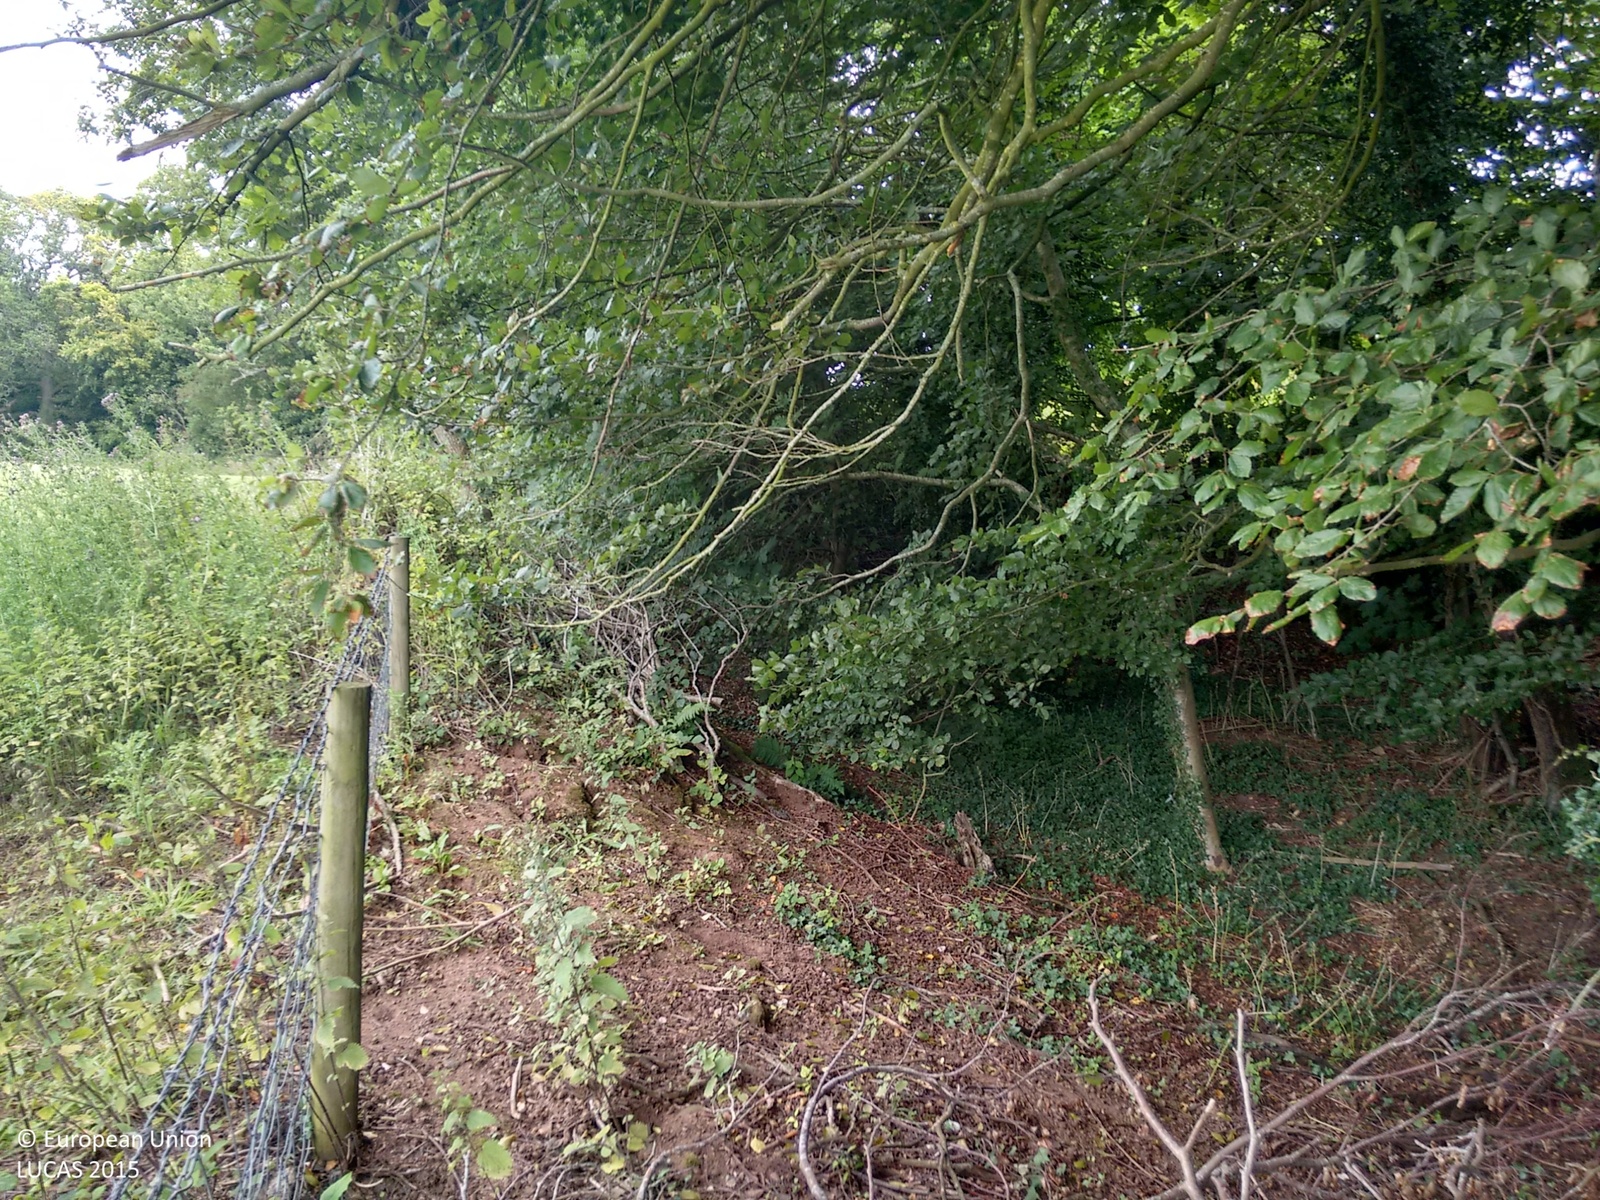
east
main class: Grassland
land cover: Grassland without tree/shrub cover
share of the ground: > 75 %
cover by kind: herbaceous plants 100 %
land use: Agriculture (excluding fallow land and kitchen gardens)
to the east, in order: Grassland without tree/shrub cover; Shruby margins; Fences; Broadleaved woodland; Grassland without tree/shrub cover; Tracks; Grass margins; Broadleaved woodland; Ditches and canals; Shruby margins; Temporary grasslands
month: August
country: GB
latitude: 50.5896
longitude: -3.5747
